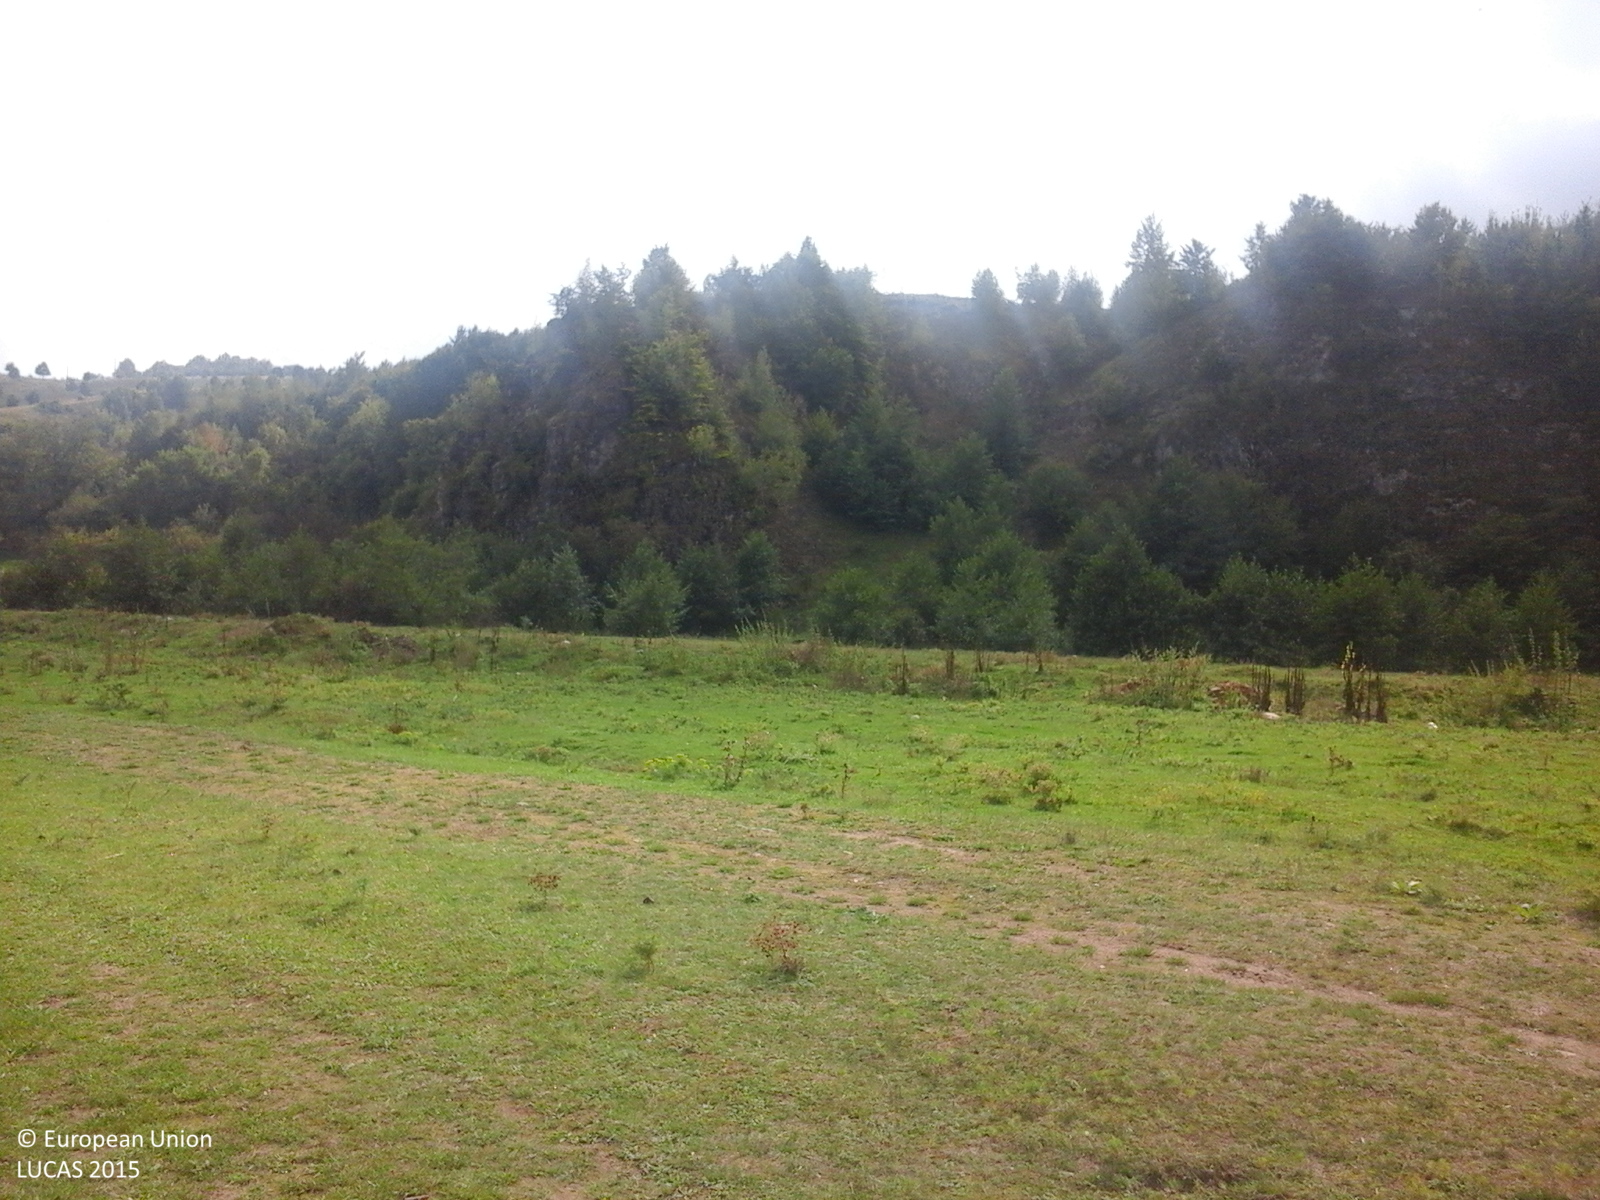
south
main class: Grassland
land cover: Grassland without tree/shrub cover
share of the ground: > 75 %
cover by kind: herbaceous plants 100 %
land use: Agriculture (excluding fallow land and kitchen gardens)
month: September
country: RO
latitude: 46.9357
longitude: 22.5731
